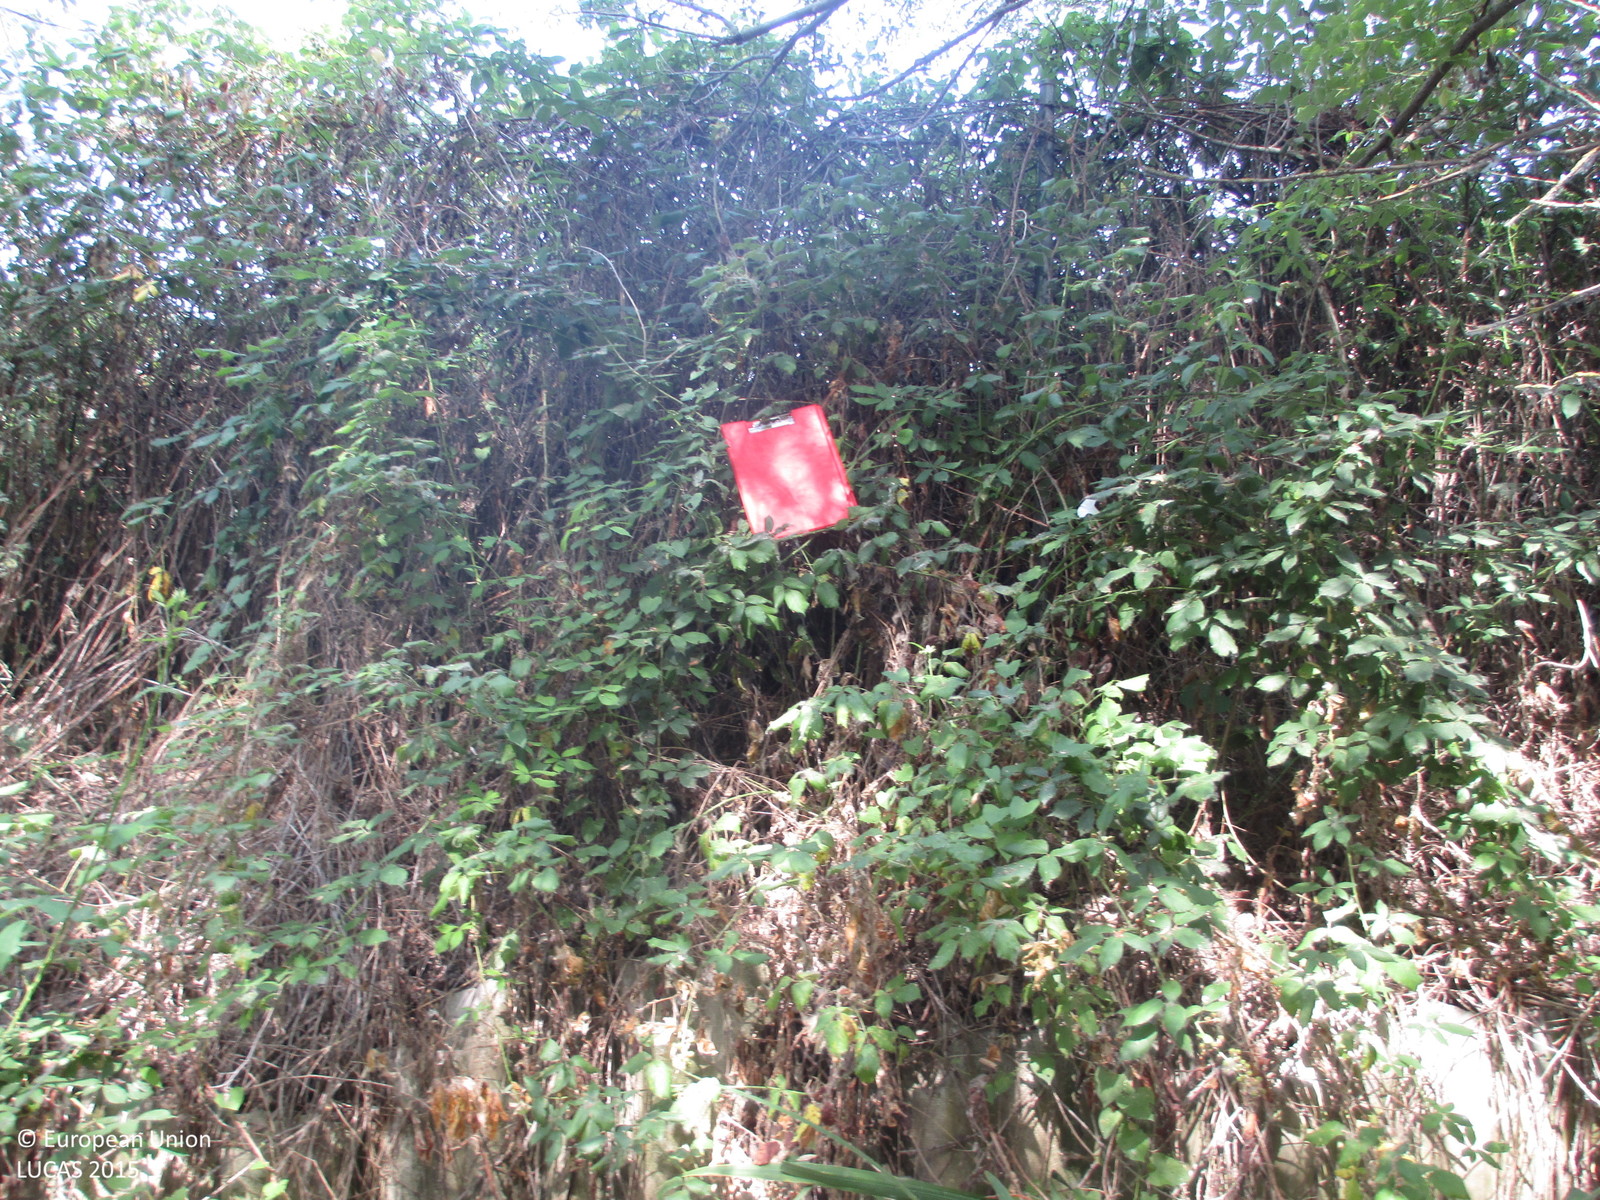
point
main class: Woodland
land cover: Broadleaved woodland
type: floodplain forest
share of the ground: > 75 %
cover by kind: broadleaved forest trees 100 %
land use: Semi-natural and natural areas not in use
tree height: > 5 m
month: July
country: ES
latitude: 42.1725
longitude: 0.3337
